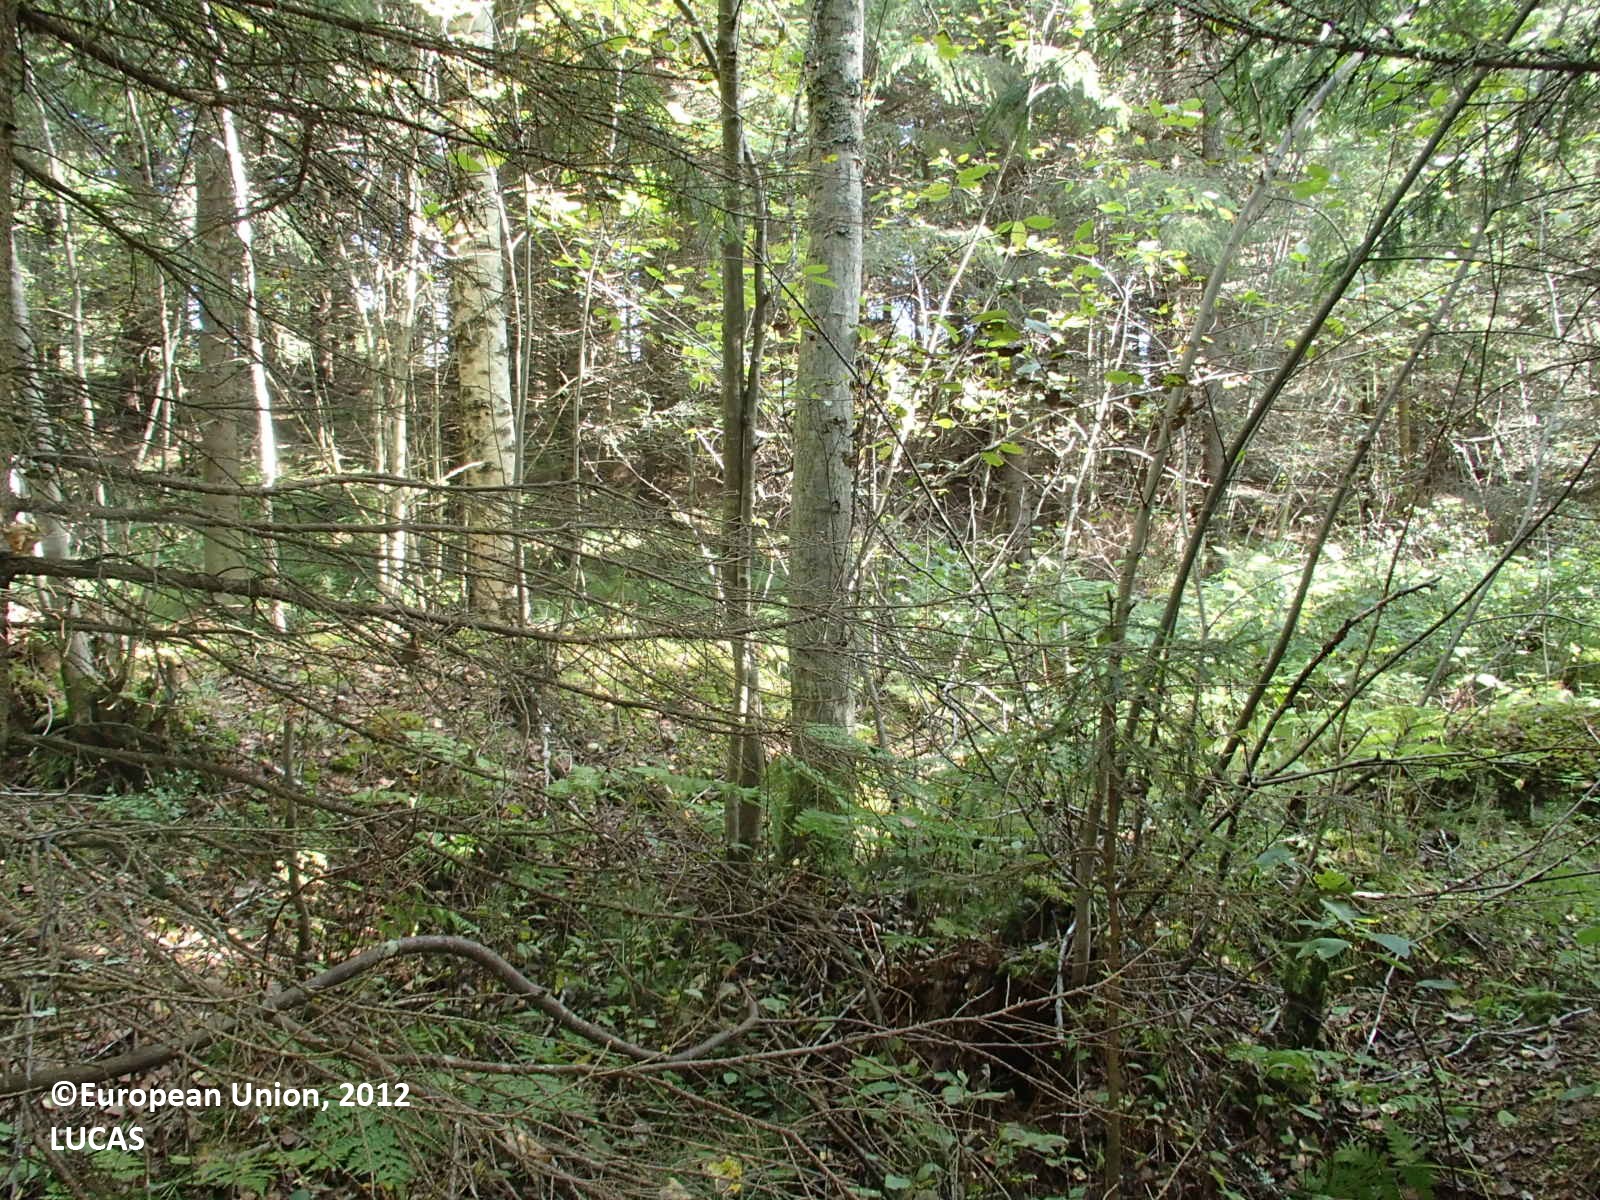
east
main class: Woodland
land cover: Spruce dominated mixed woodland
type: boreal forest
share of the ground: > 75 %
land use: Forestry
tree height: > 5 m
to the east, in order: Spruce dominated mixed woodland; Spruce dominated coniferous woodland; Ditches and canals; Grass margins; Electric lines; Paved roads, cycling and walking lanes; Grass margins; Fences; Artificial constructions in urban areas; Fences; Grassland with sparse tree/shrub cover; Electric lines; Grassland without tree/shrub cover; Pine dominated mixed woodland
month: August
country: FI
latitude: 63.6292
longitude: 27.0714
